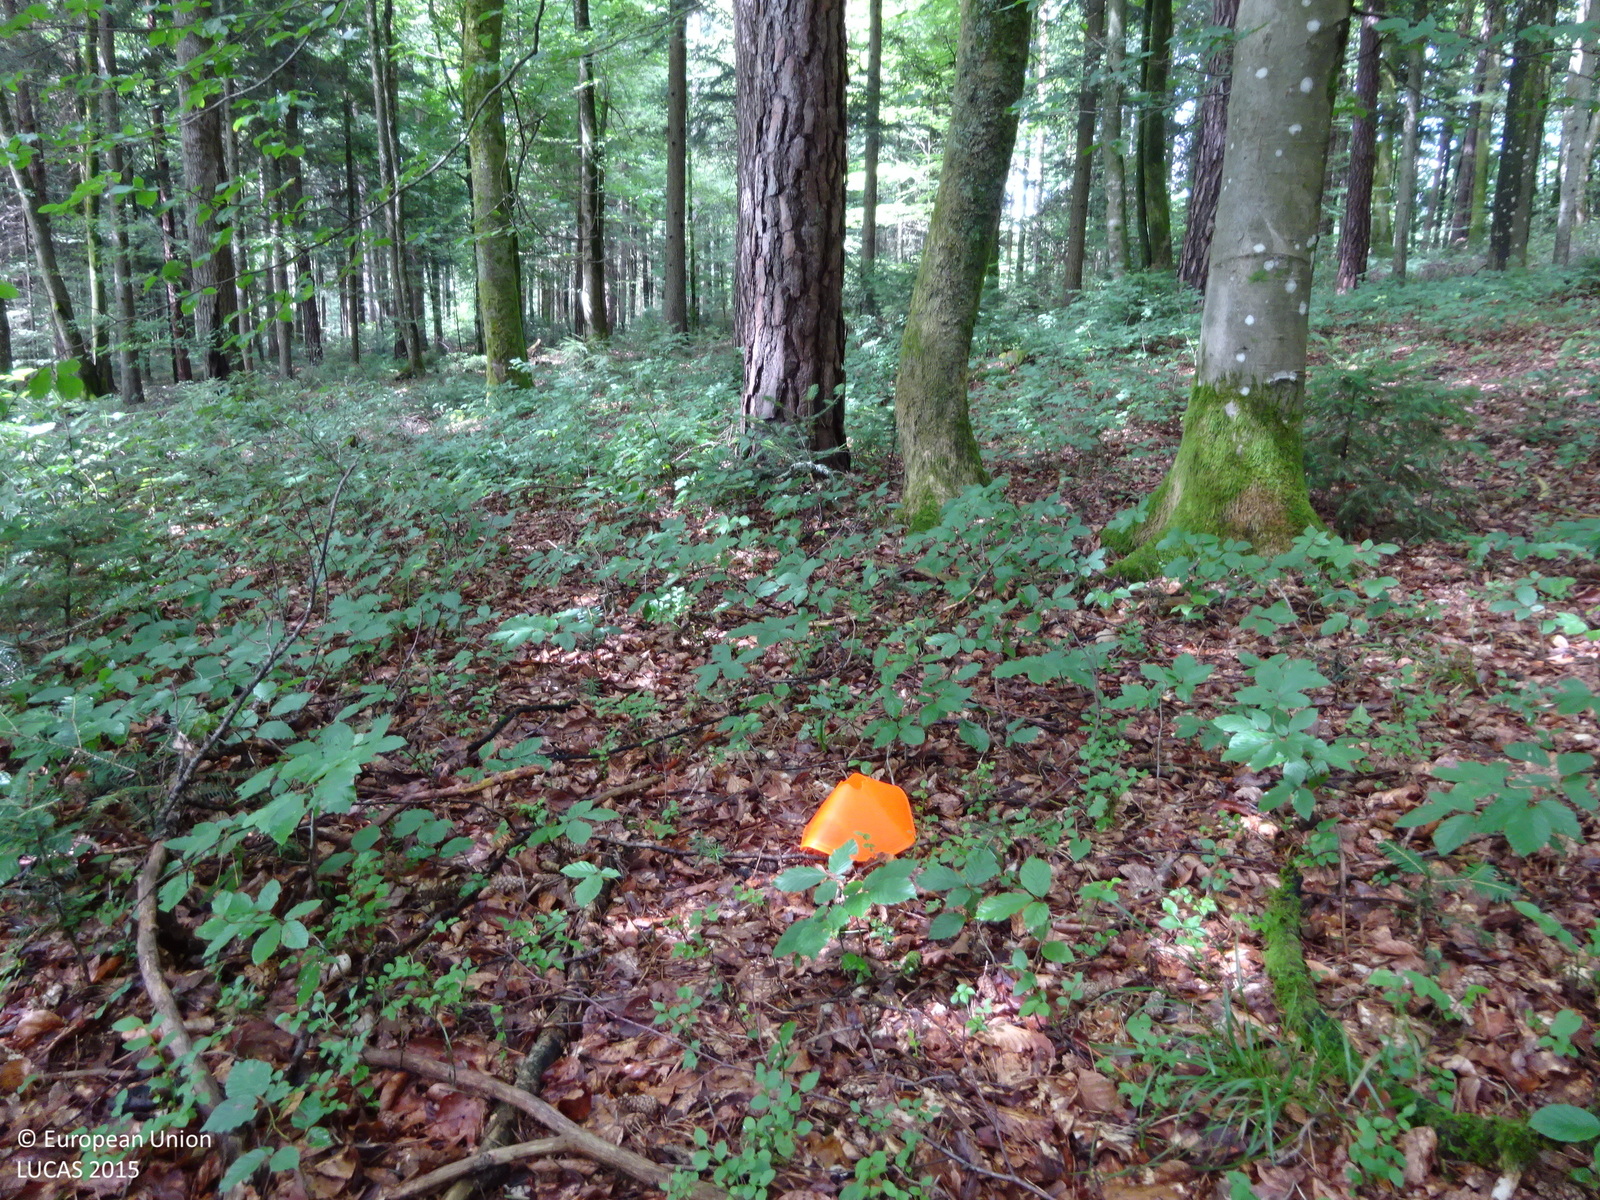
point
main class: Woodland
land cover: Pine dominated mixed woodland
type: mountainous beech forest
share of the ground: > 75 %
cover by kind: broadleaved forest trees 65 %, coniferous forest trees 25 %, herbaceous plants 10 %
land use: Forestry
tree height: > 5 m
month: July
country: AT
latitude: 46.8509
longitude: 15.3106
